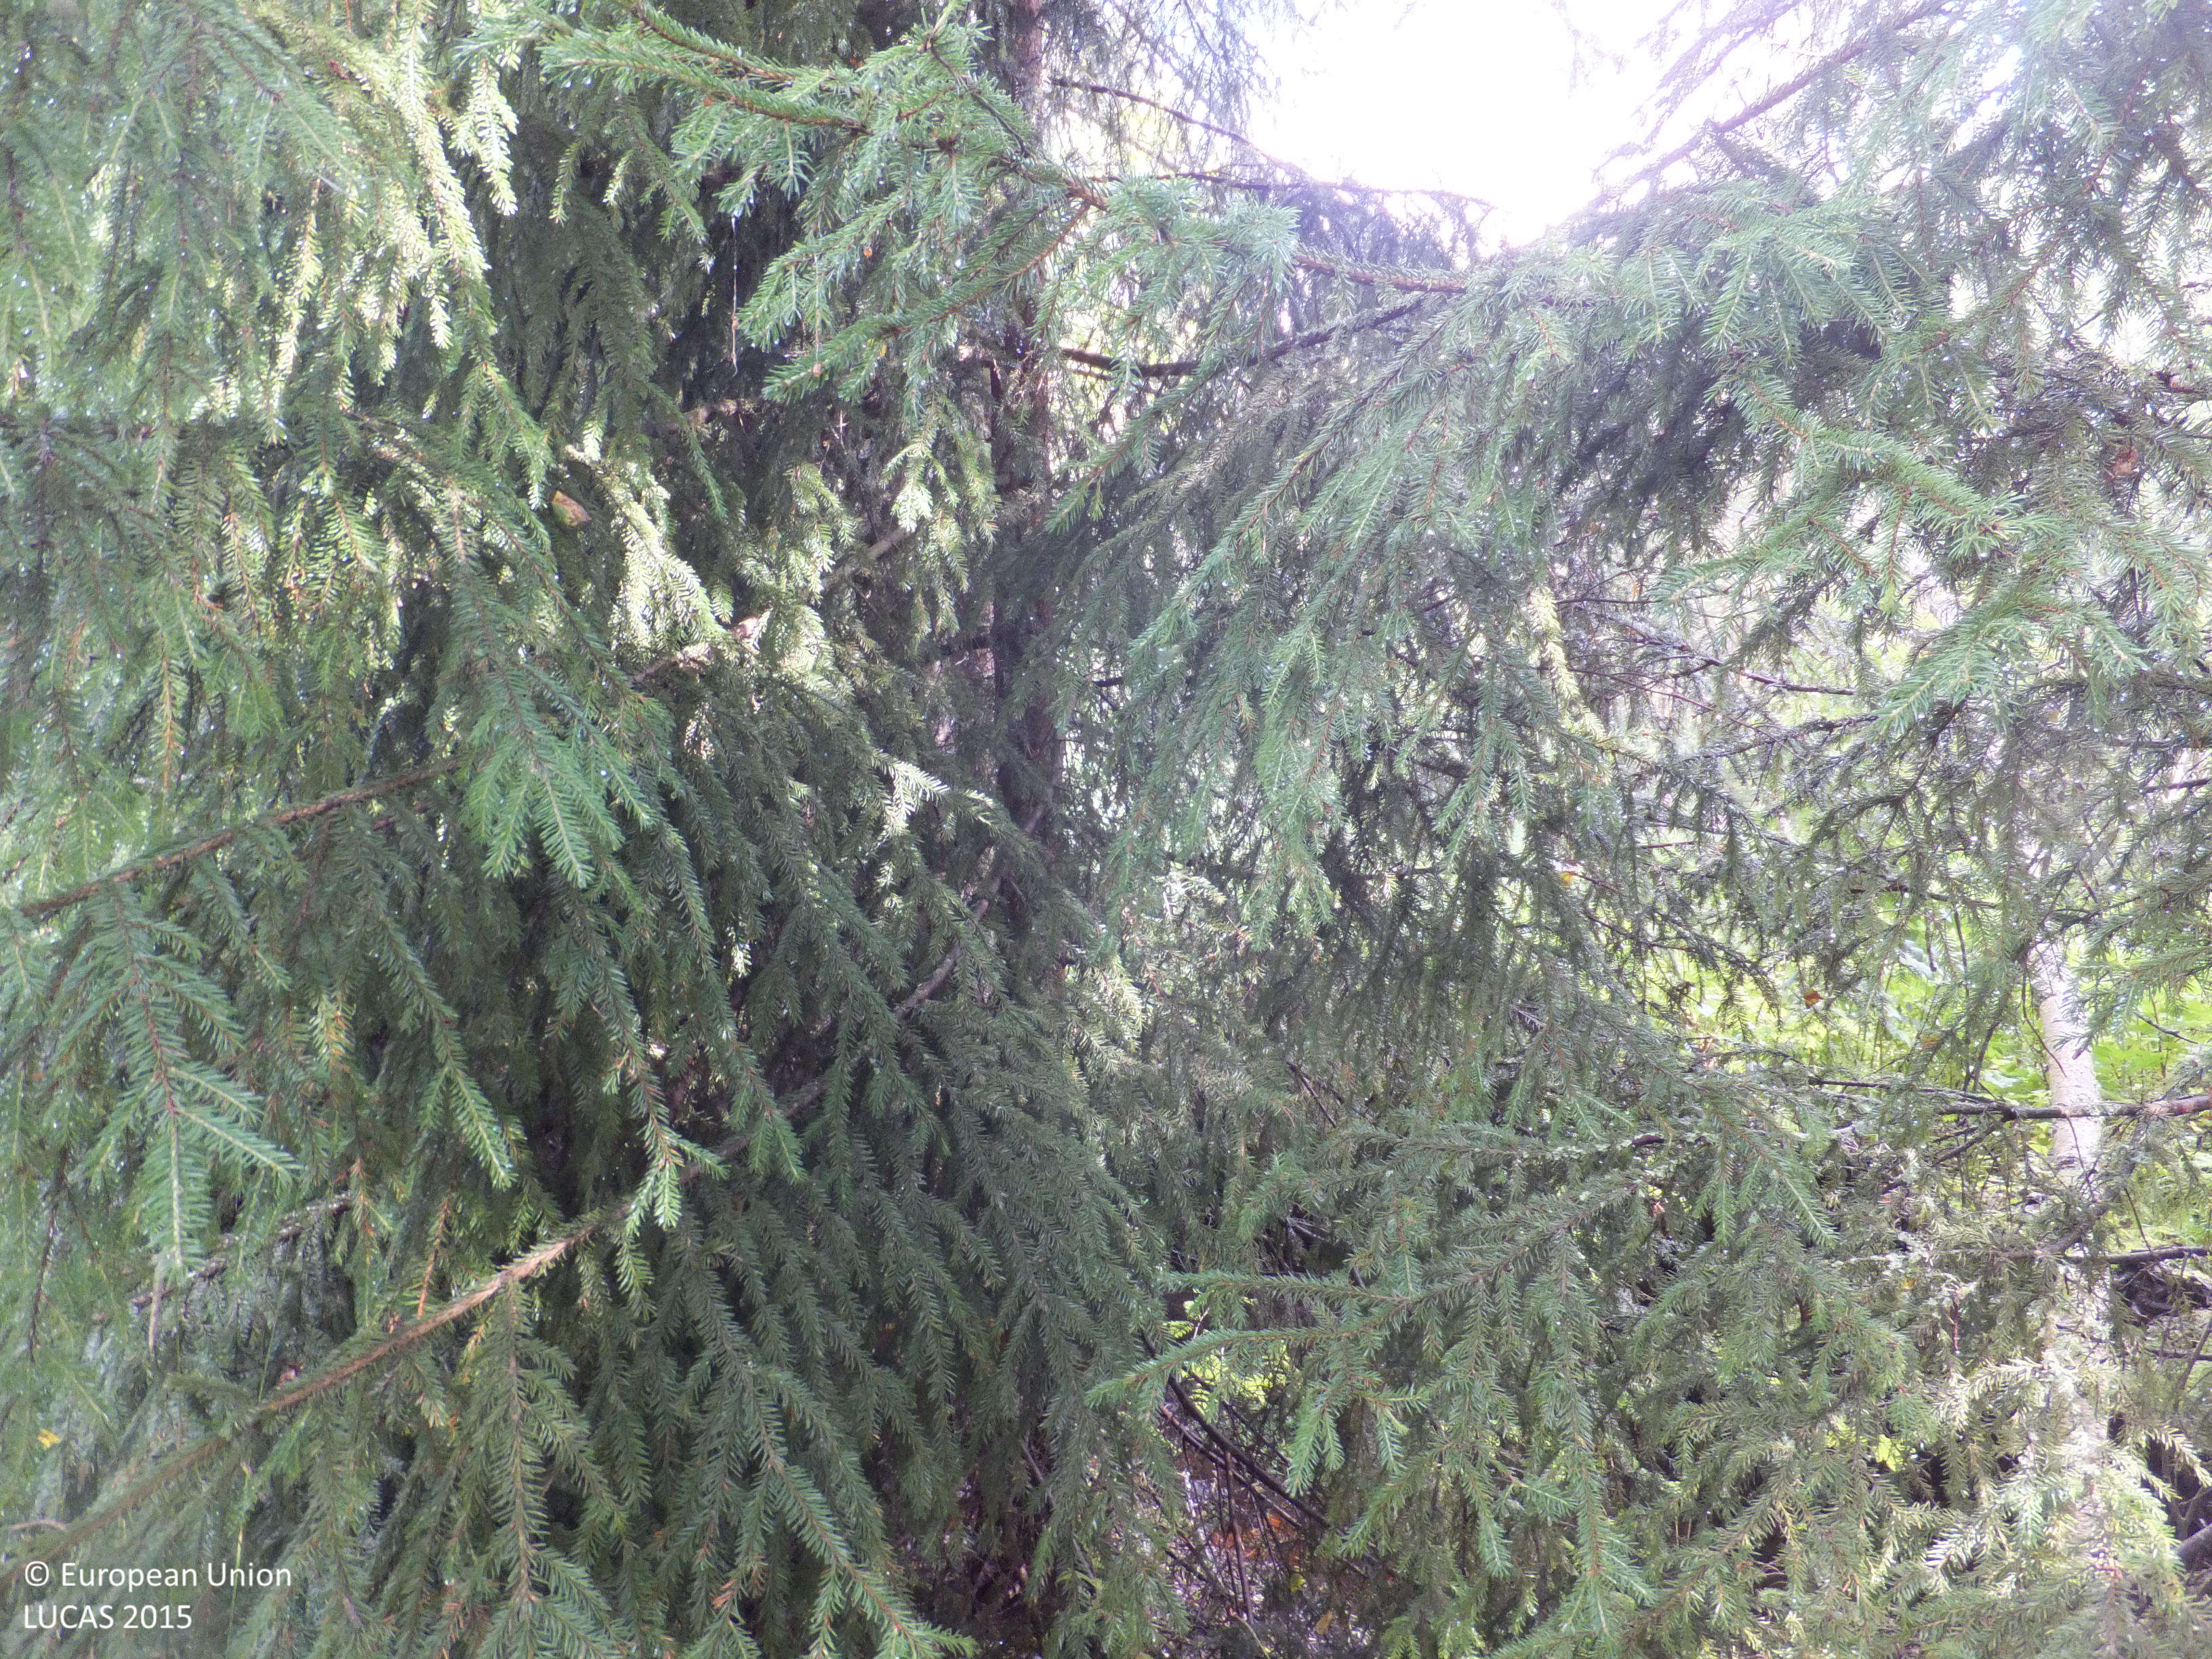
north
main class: Woodland
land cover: Spruce dominated mixed woodland
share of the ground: 50 - 75 %
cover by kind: herbaceous plants 40 %, broadleaved forest trees 30 %, coniferous forest trees 20 %, shrubs 10 %
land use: Semi-natural and natural areas not in use
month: July
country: FI
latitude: 63.1919
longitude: 21.9879
